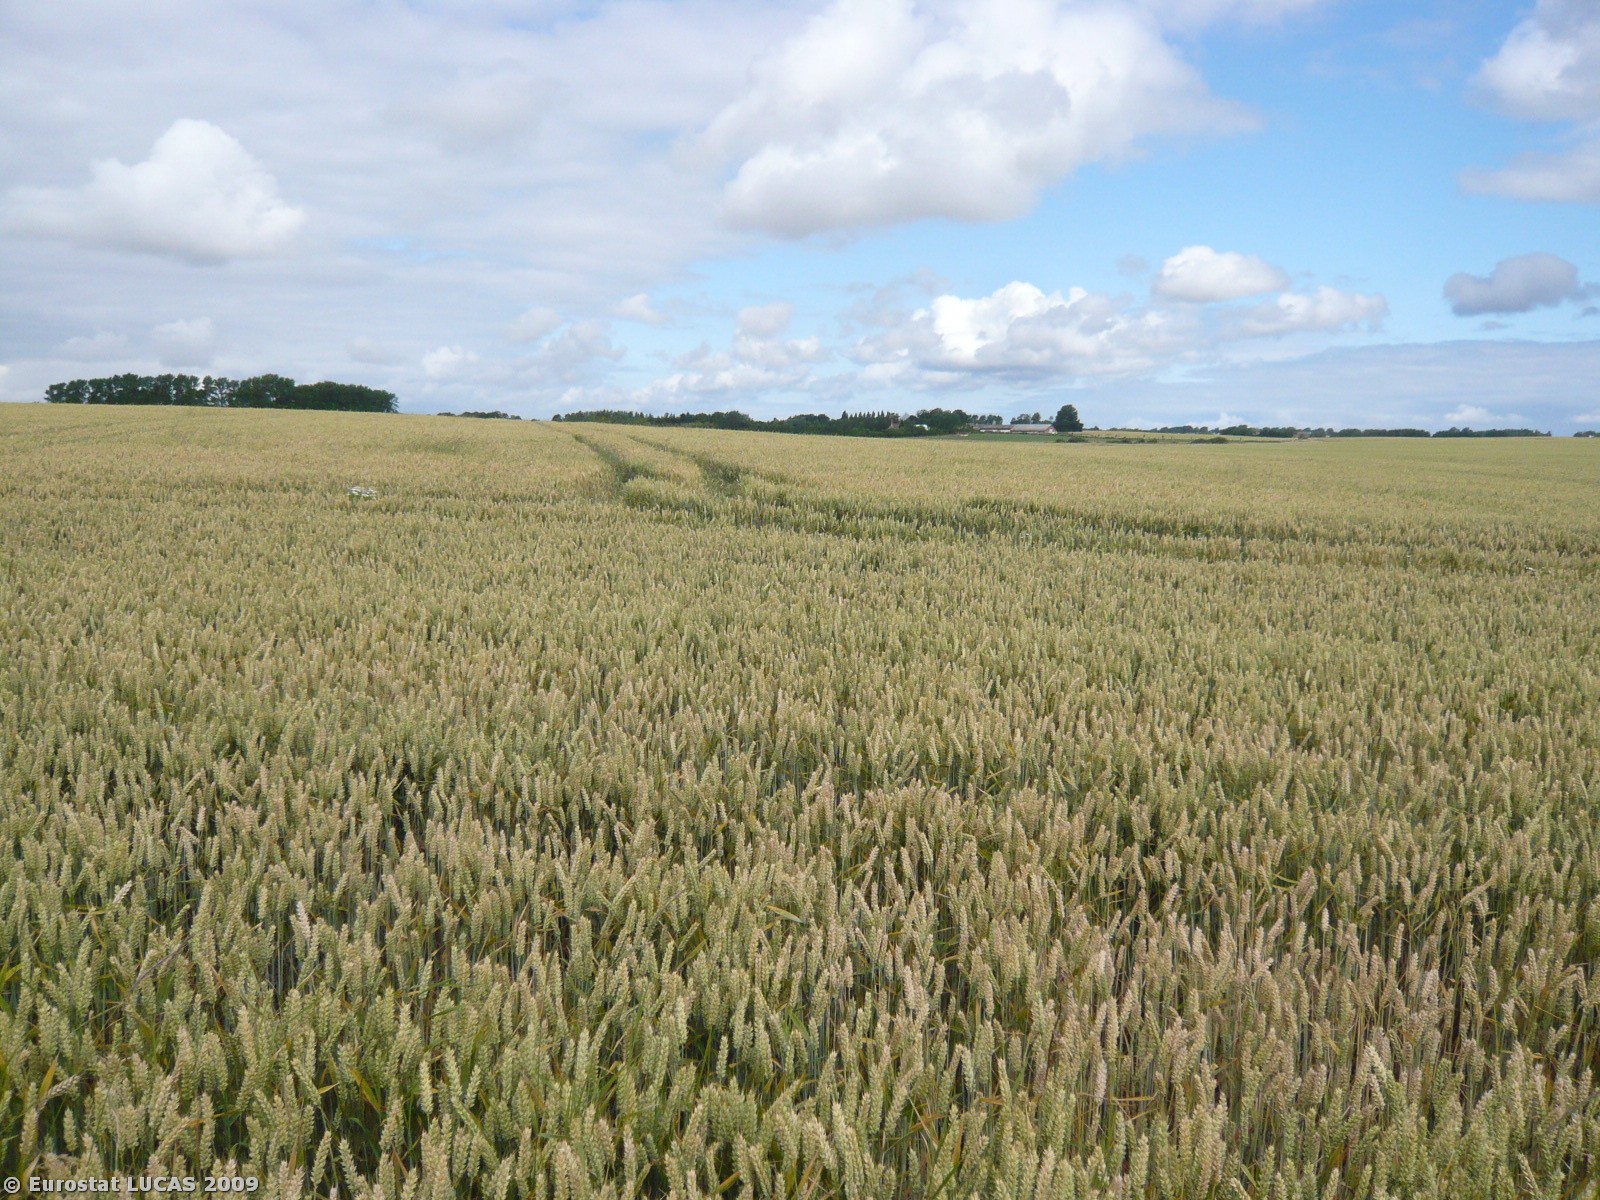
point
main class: Cropland
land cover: Common wheat
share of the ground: > 75 %
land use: Agriculture (excluding fallow land and kitchen gardens)
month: July
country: DK
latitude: 55.5884
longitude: 11.2523
